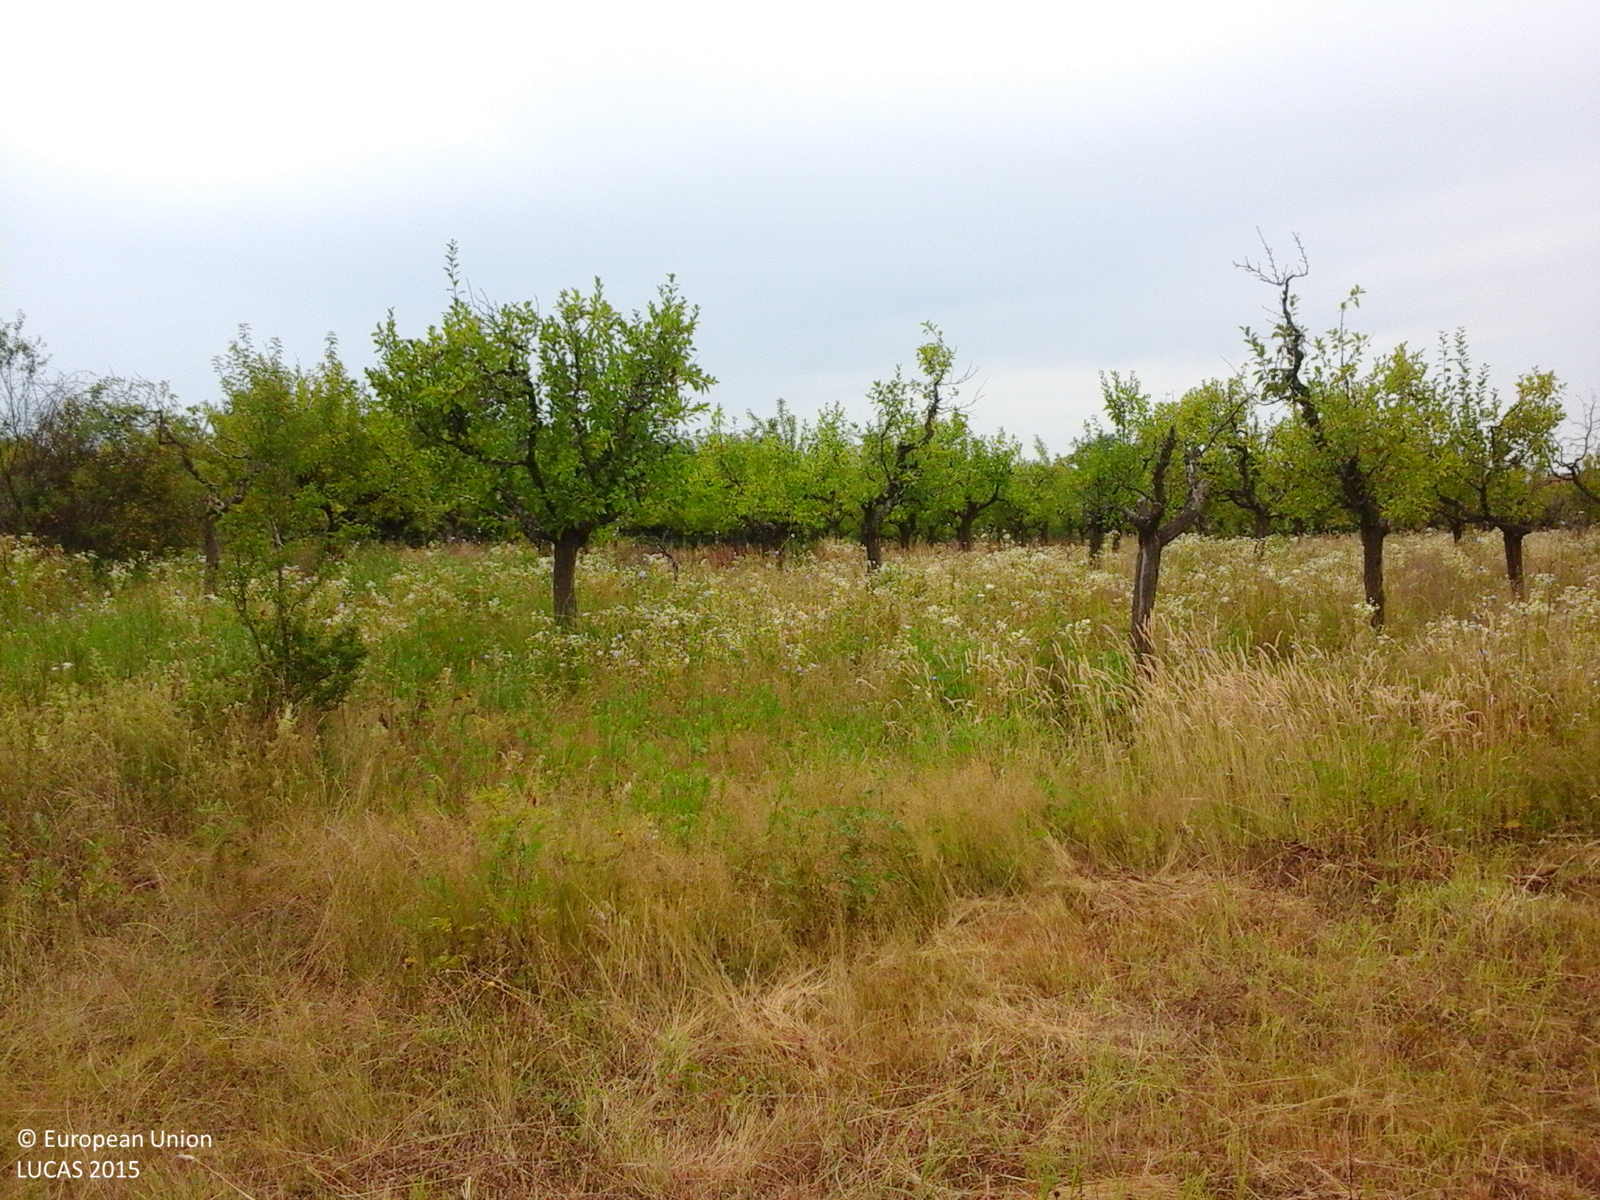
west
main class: Cropland
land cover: Other fruit trees and berries
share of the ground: > 75 %
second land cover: Grassland without tree/shrub cover
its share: > 75 %
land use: Agriculture (excluding fallow land and kitchen gardens)
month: July
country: RO
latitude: 44.8007
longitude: 24.4210
